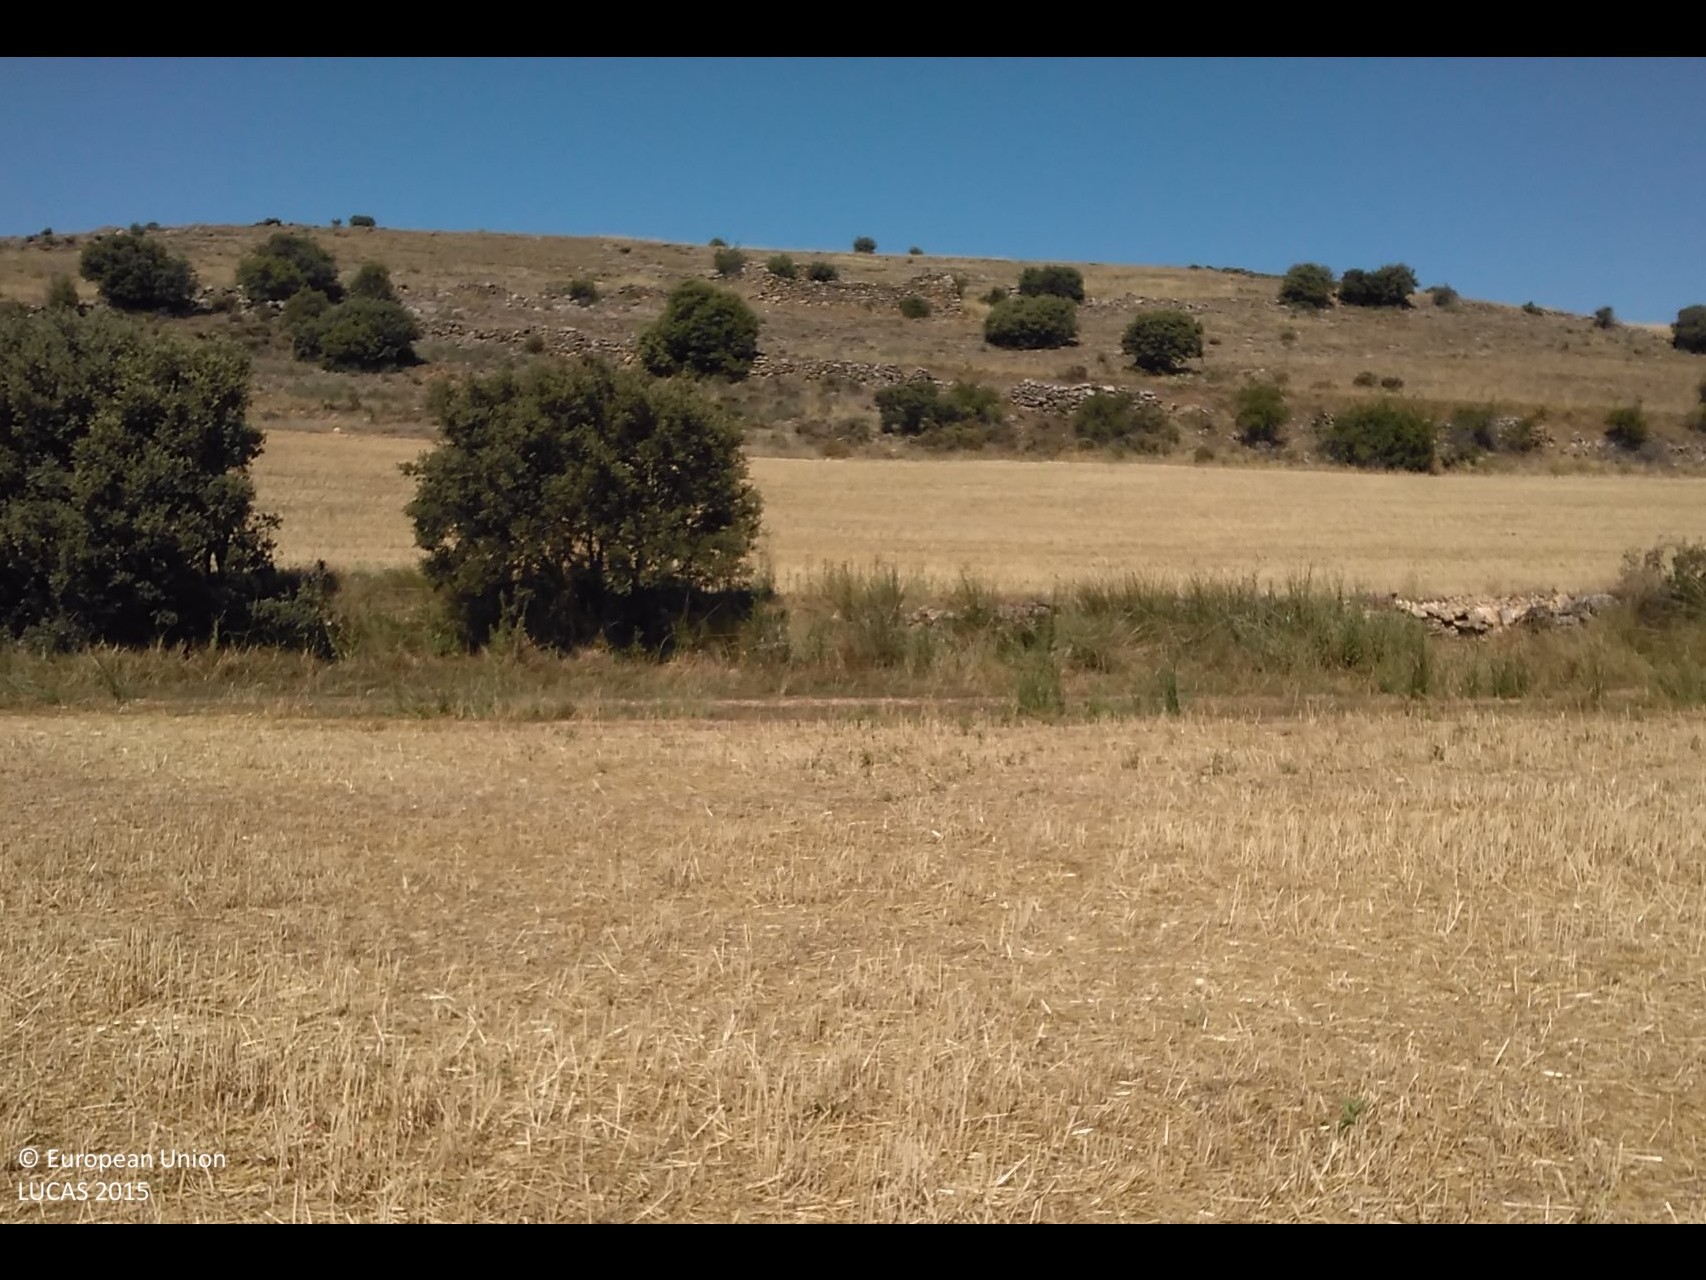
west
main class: Cropland
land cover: Common wheat
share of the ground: < 10 %
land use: Agriculture (excluding fallow land and kitchen gardens)
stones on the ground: < 10 %
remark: Harvested field
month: July
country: ES
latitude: 41.5566
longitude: -1.9846
